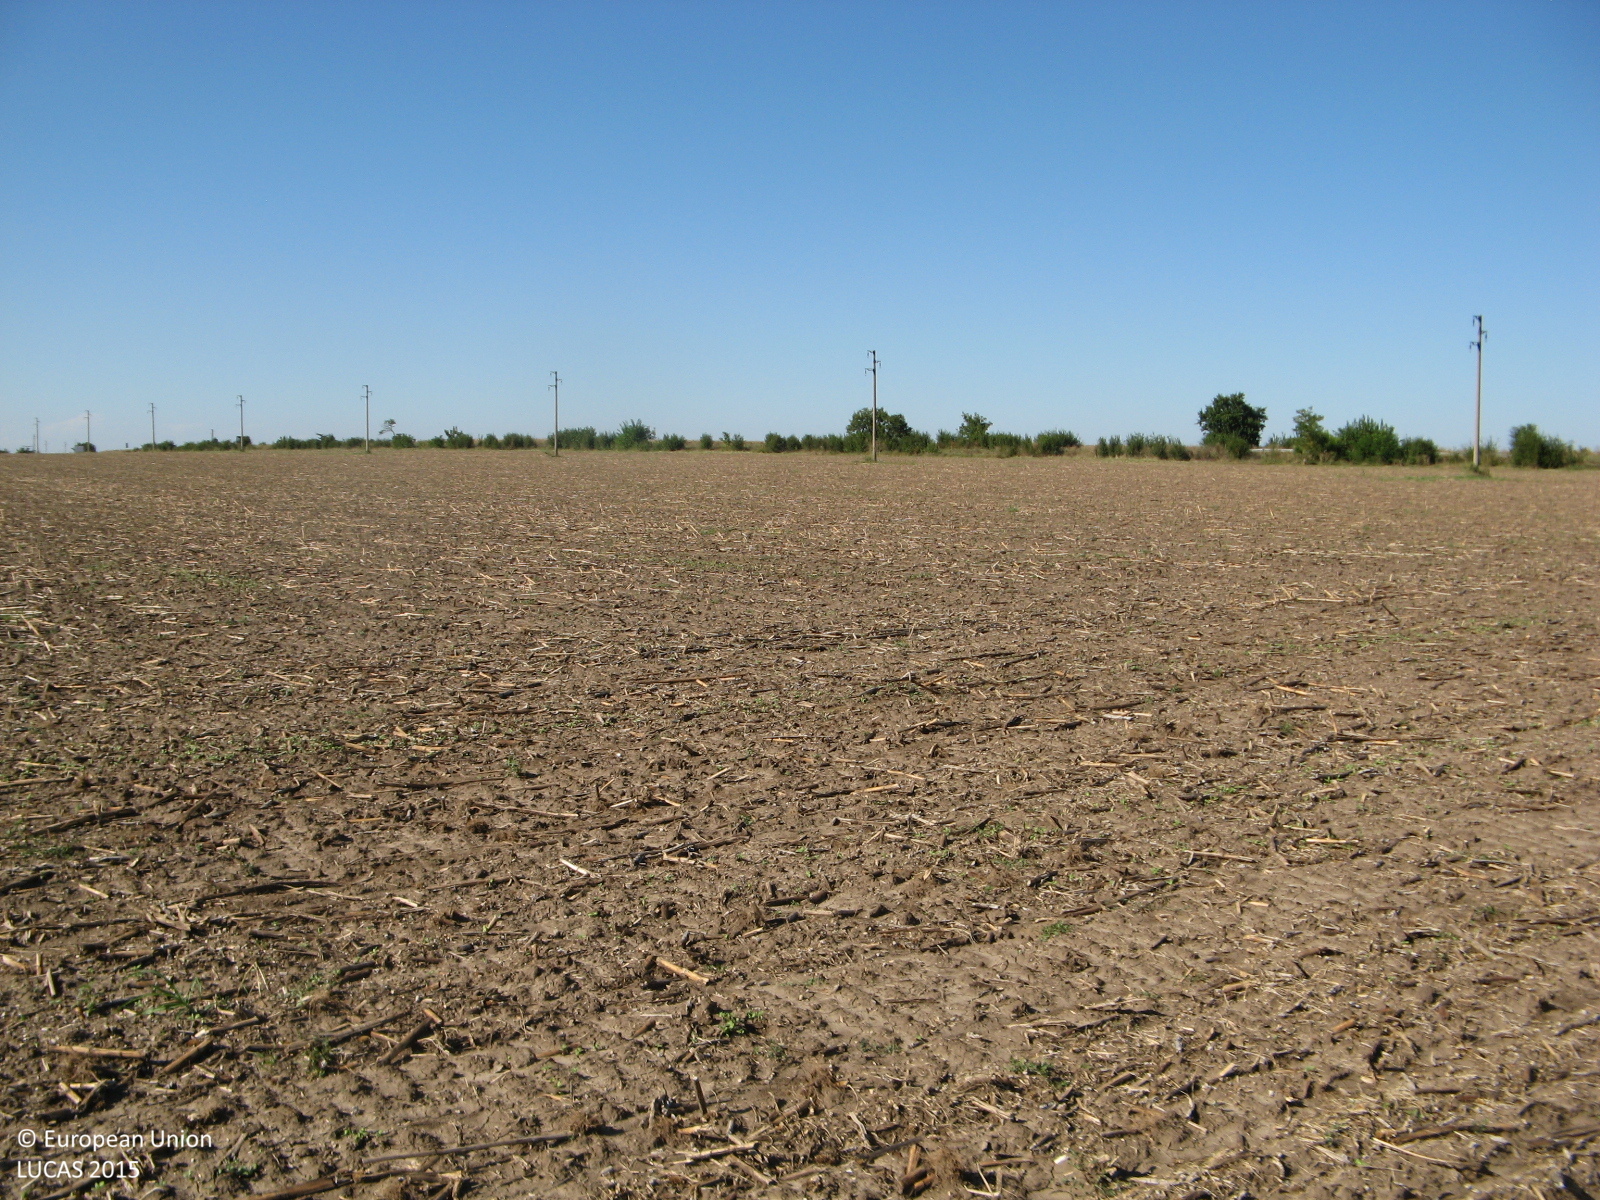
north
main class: Cropland
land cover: Sunflower
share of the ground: < 10 %
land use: Agriculture (excluding fallow land and kitchen gardens)
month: September
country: BG
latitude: 43.7263
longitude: 26.0991
